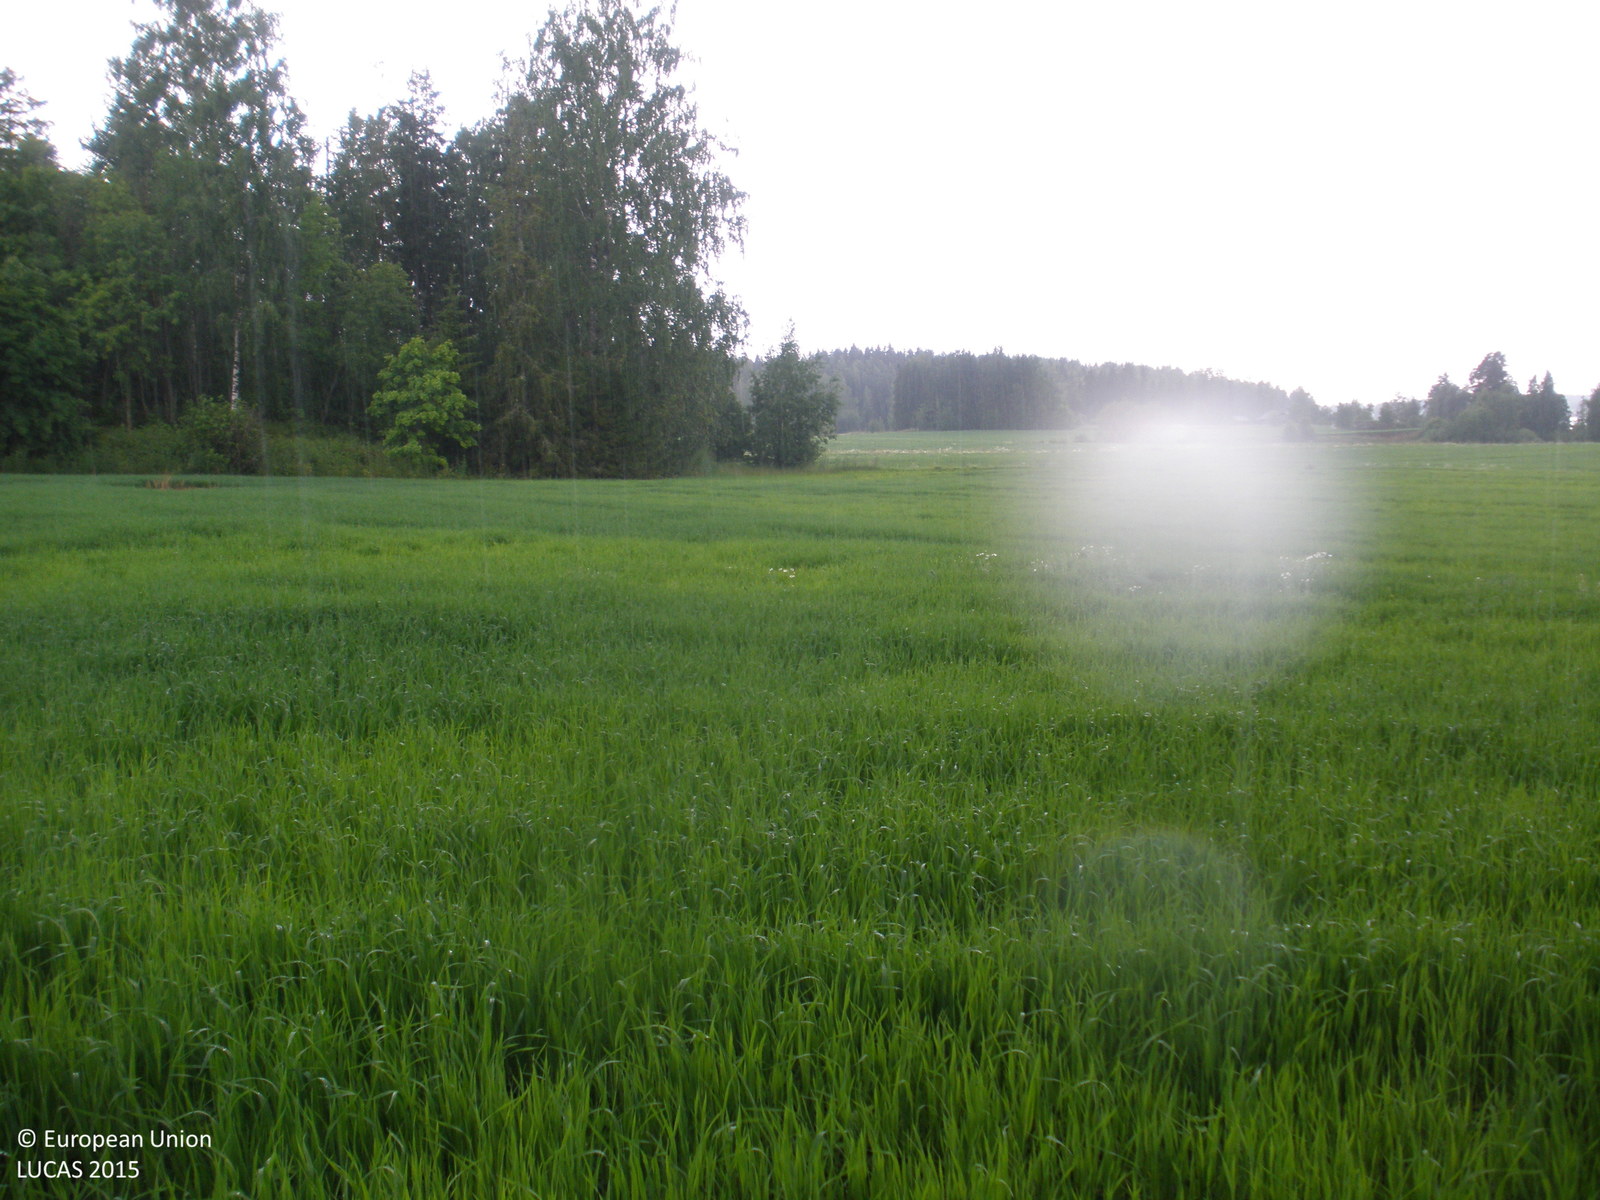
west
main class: Cropland
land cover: Oats
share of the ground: > 75 %
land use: Agriculture (excluding fallow land and kitchen gardens)
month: July
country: FI
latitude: 61.3182
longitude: 23.7386
